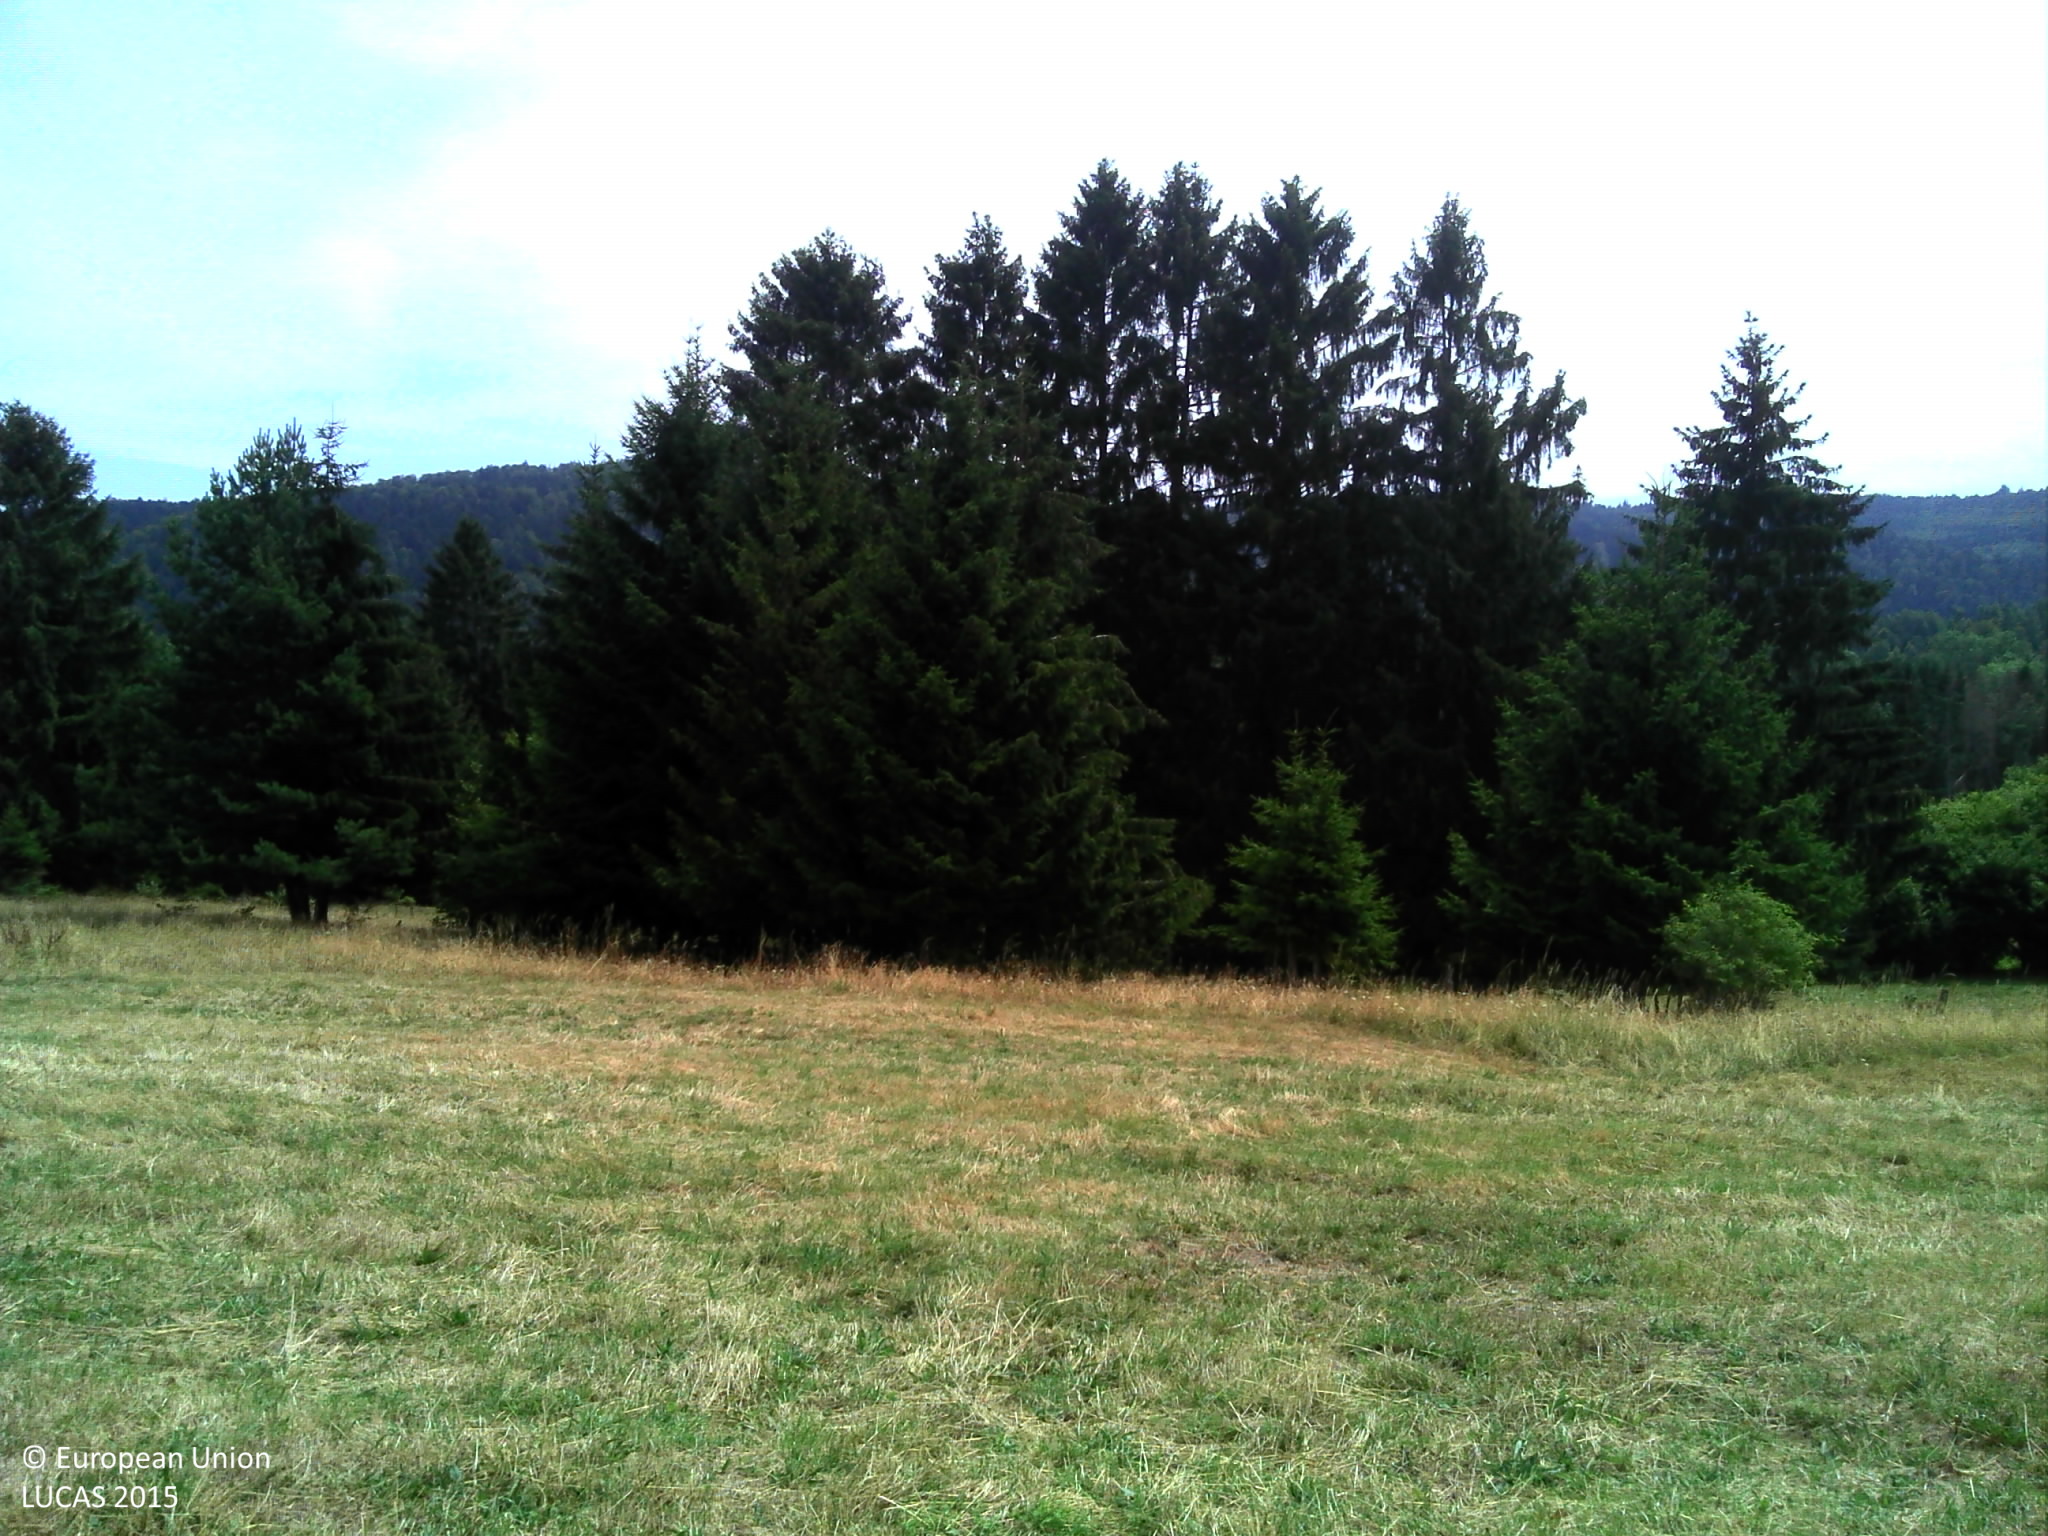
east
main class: Grassland
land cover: Grassland without tree/shrub cover
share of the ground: > 75 %
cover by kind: herbaceous plants 100 %
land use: Agriculture (excluding fallow land and kitchen gardens)
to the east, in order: Grassland without tree/shrub cover; Spruce dominated coniferous woodland; Fences; Grass margins; Tracks; Grass margins; Fences; Spruce dominated coniferous woodland; Fences; Broadleaved woodland
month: July
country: FR
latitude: 48.4788
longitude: 7.3088
